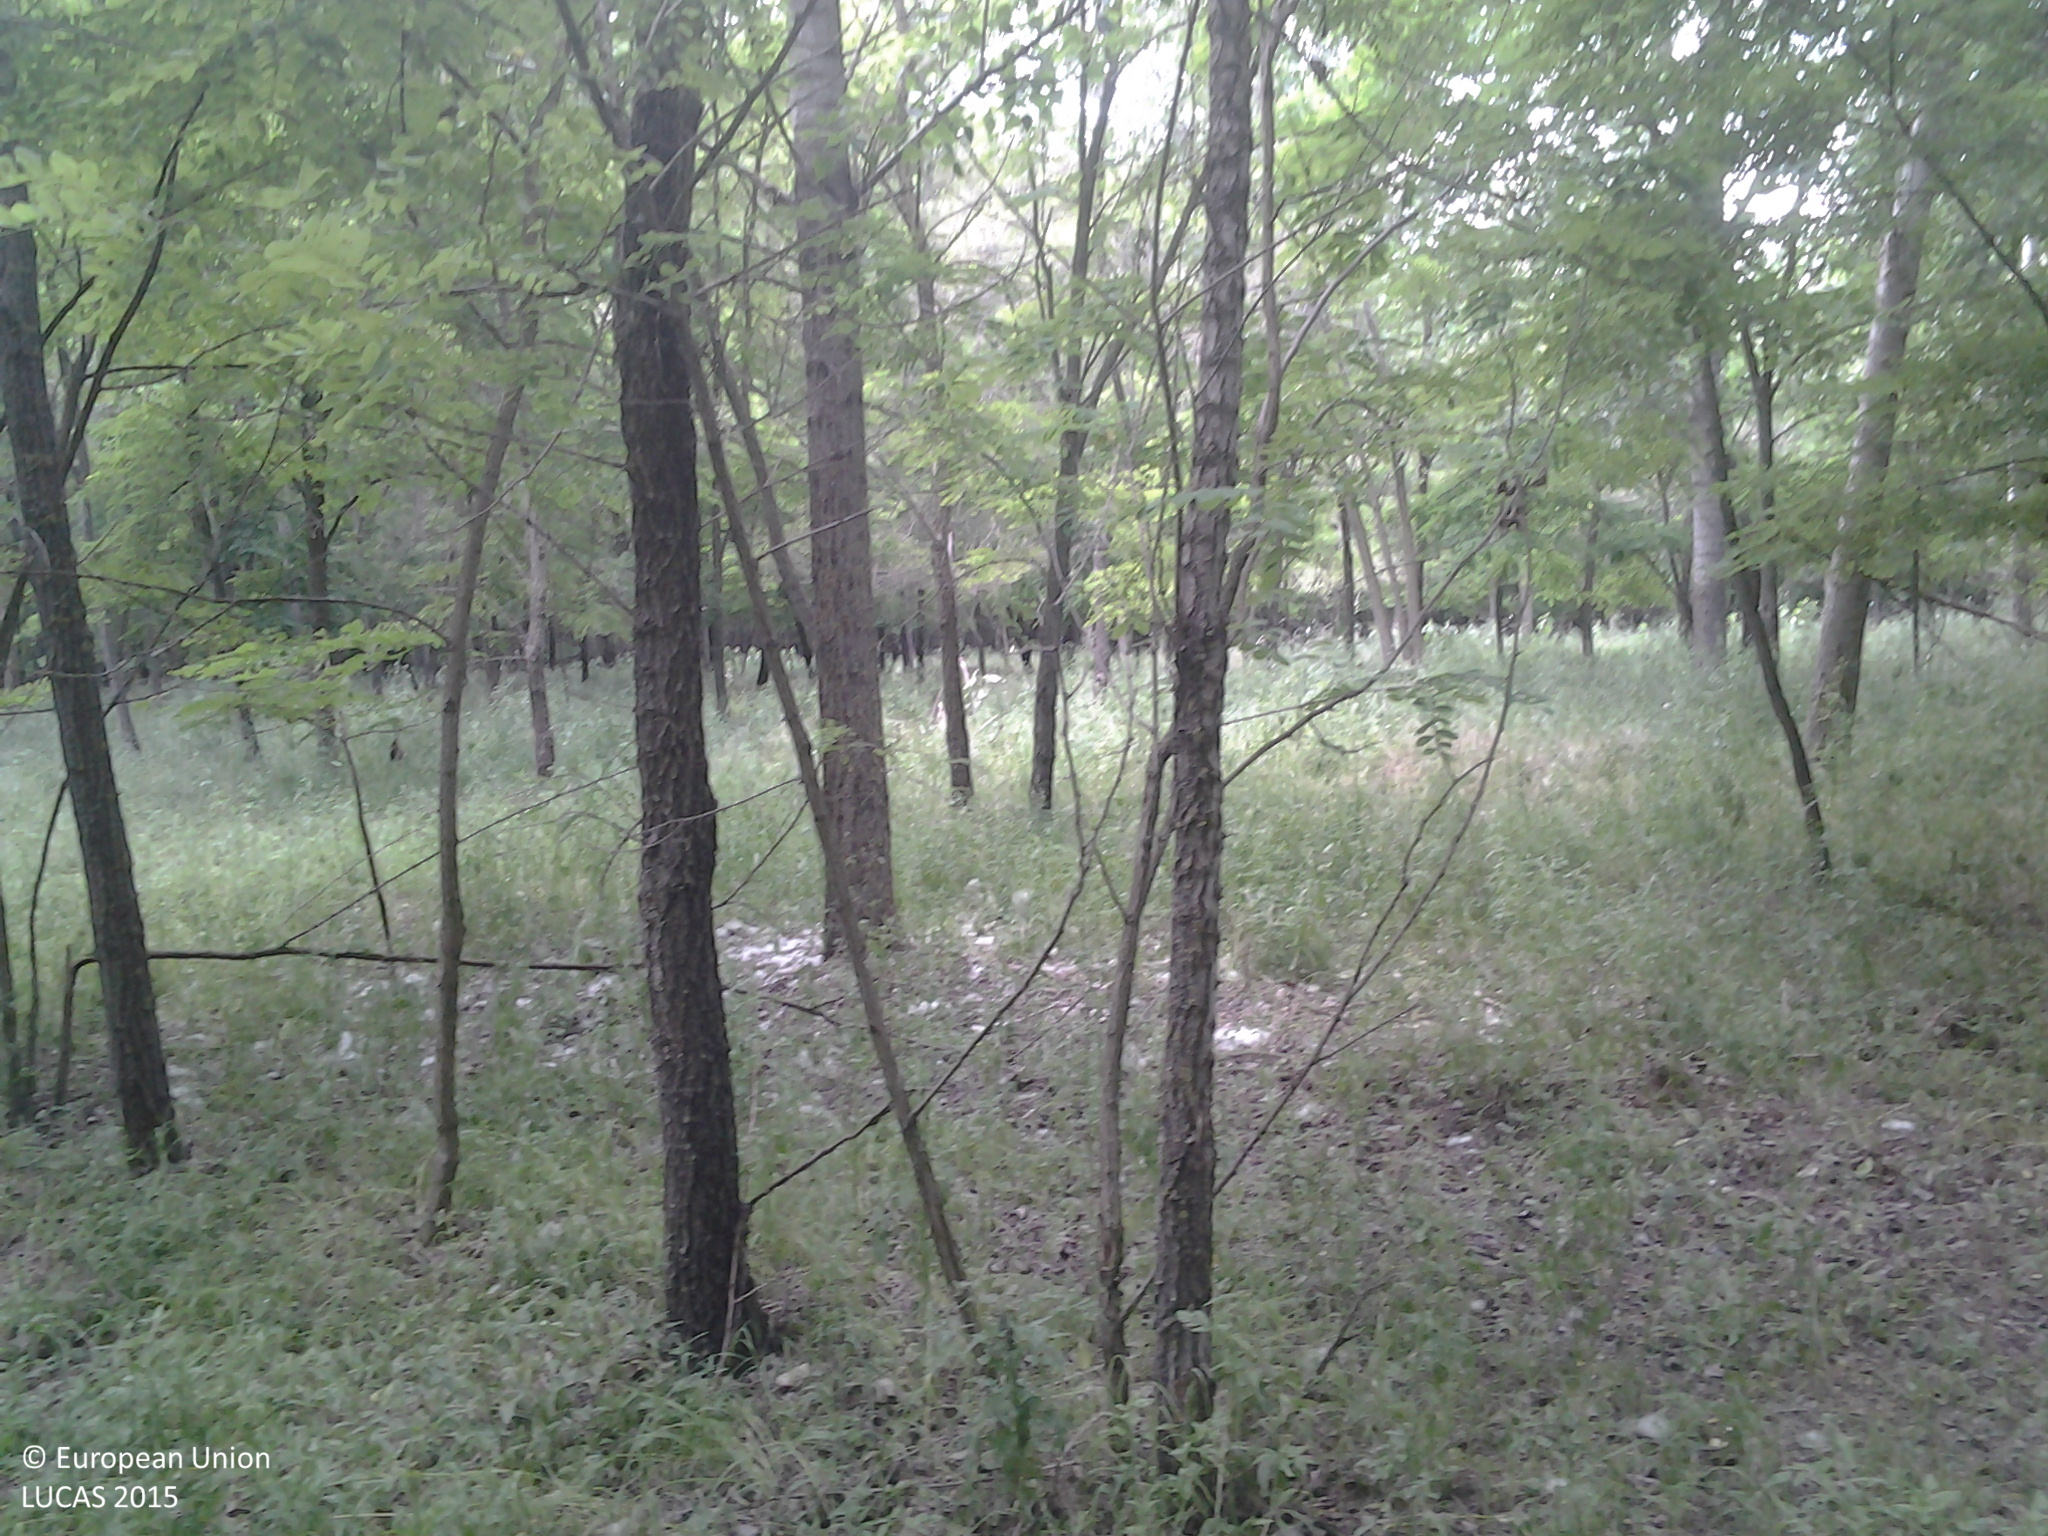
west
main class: Woodland
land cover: Broadleaved woodland
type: mesophytic deciduous forest
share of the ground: 25 - 50 %
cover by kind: broadleaved forest trees 100 %
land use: Forestry
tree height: > 5 m
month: June
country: HU
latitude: 46.7929
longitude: 19.7546
